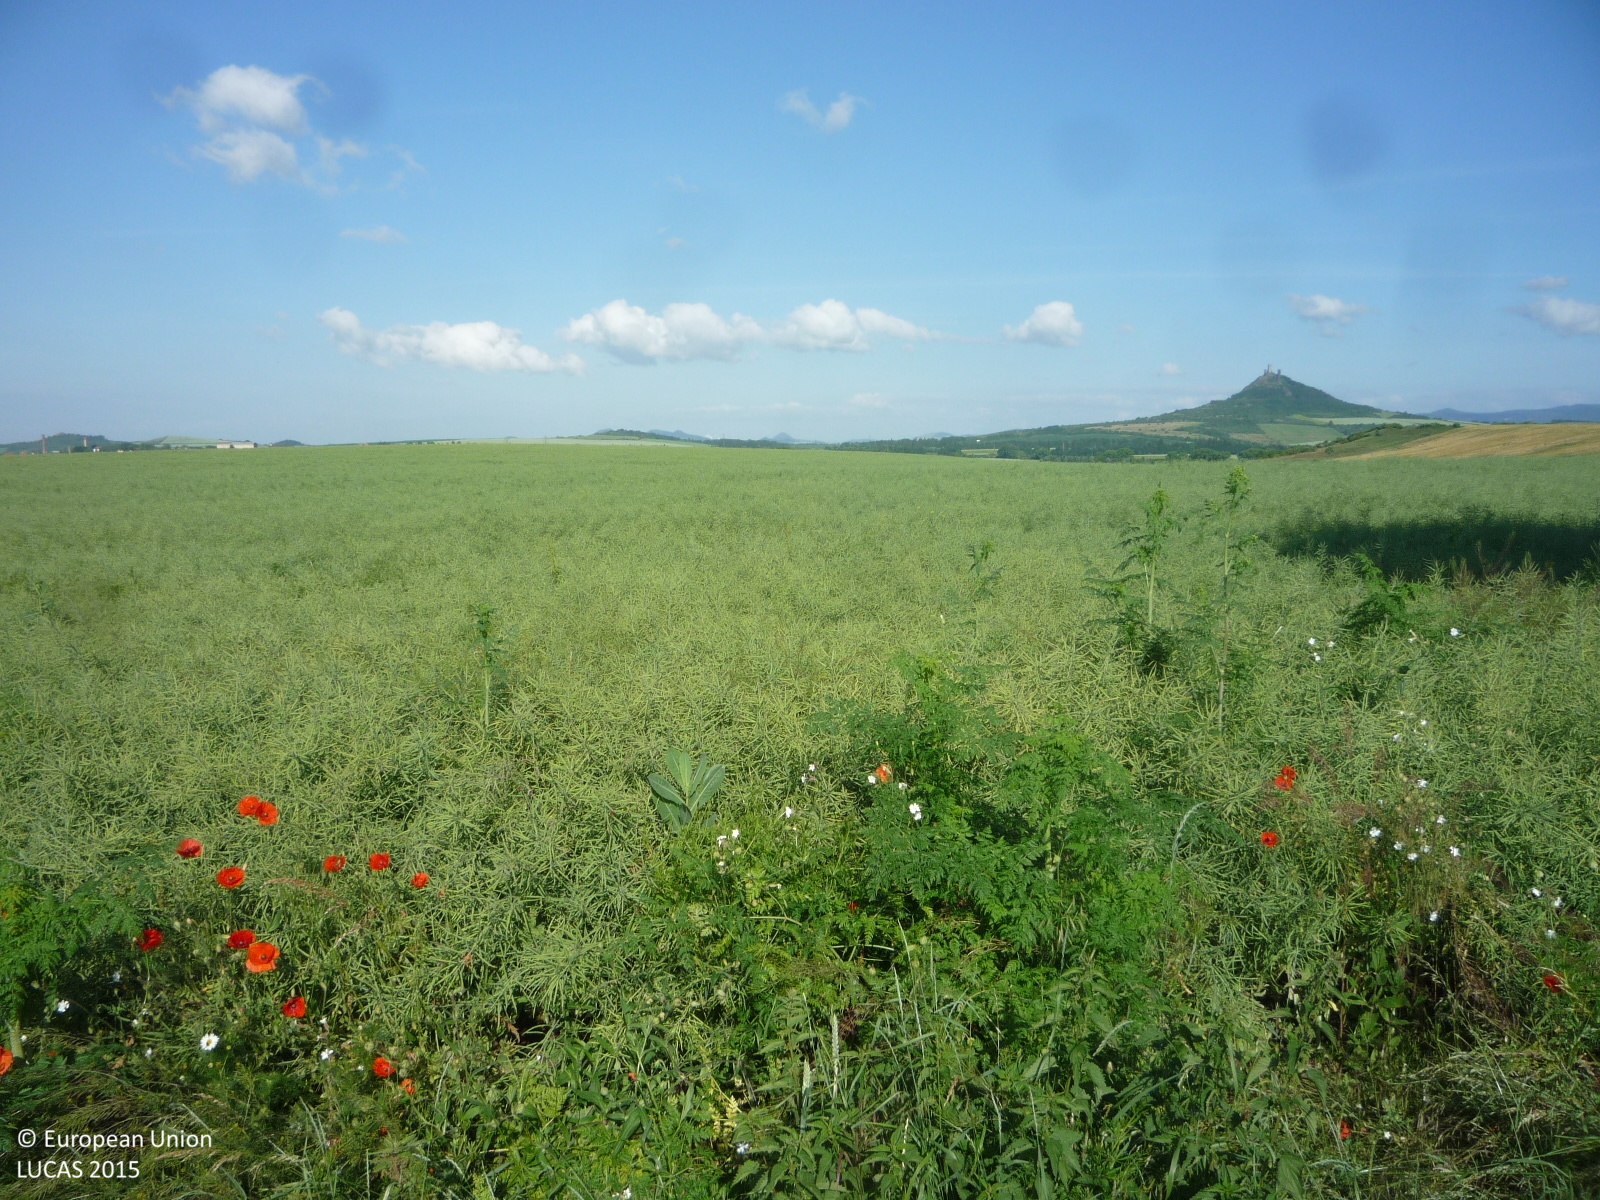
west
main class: Cropland
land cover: Rape and turnip rape
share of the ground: > 75 %
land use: Agriculture (excluding fallow land and kitchen gardens)
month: June
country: CZ
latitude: 50.4178
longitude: 14.0684
